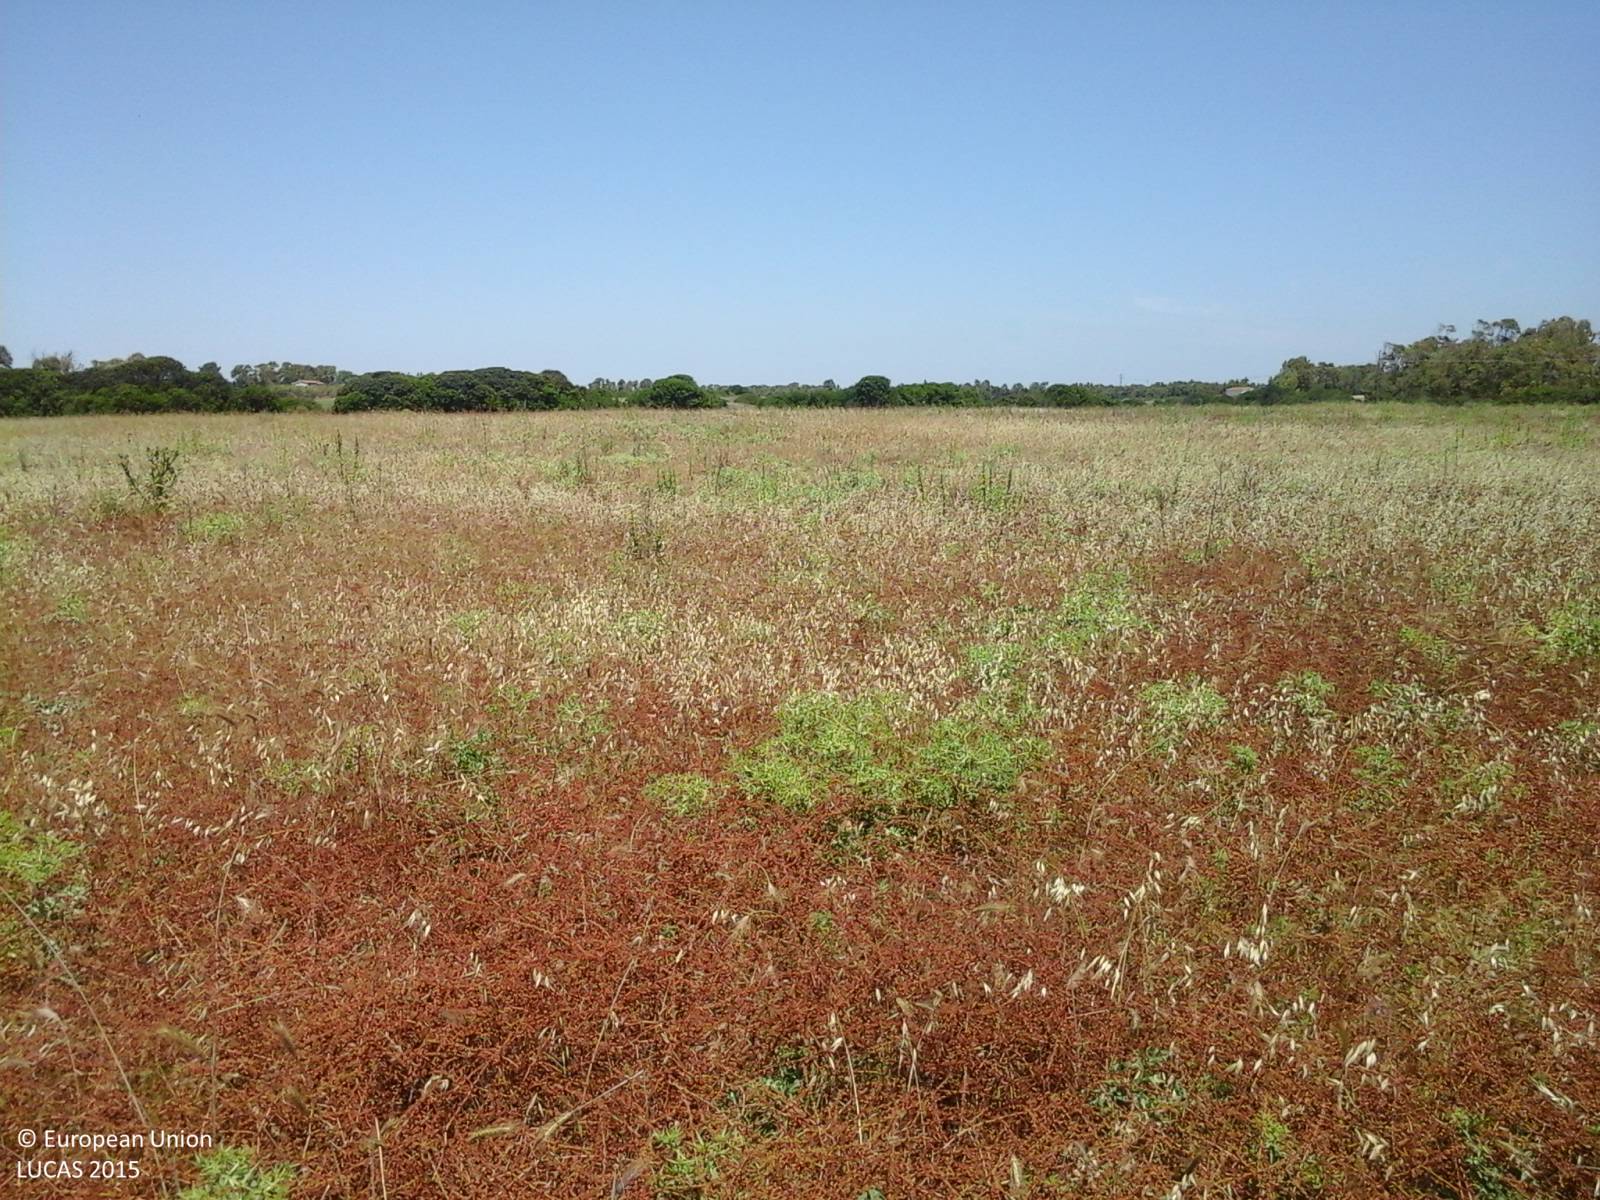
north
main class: Grassland
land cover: Spontaneously vegetated surfaces
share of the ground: > 75 %
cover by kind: herbaceous plants 100 %
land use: Fallow land
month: June
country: IT
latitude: 40.6154
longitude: 8.3415
